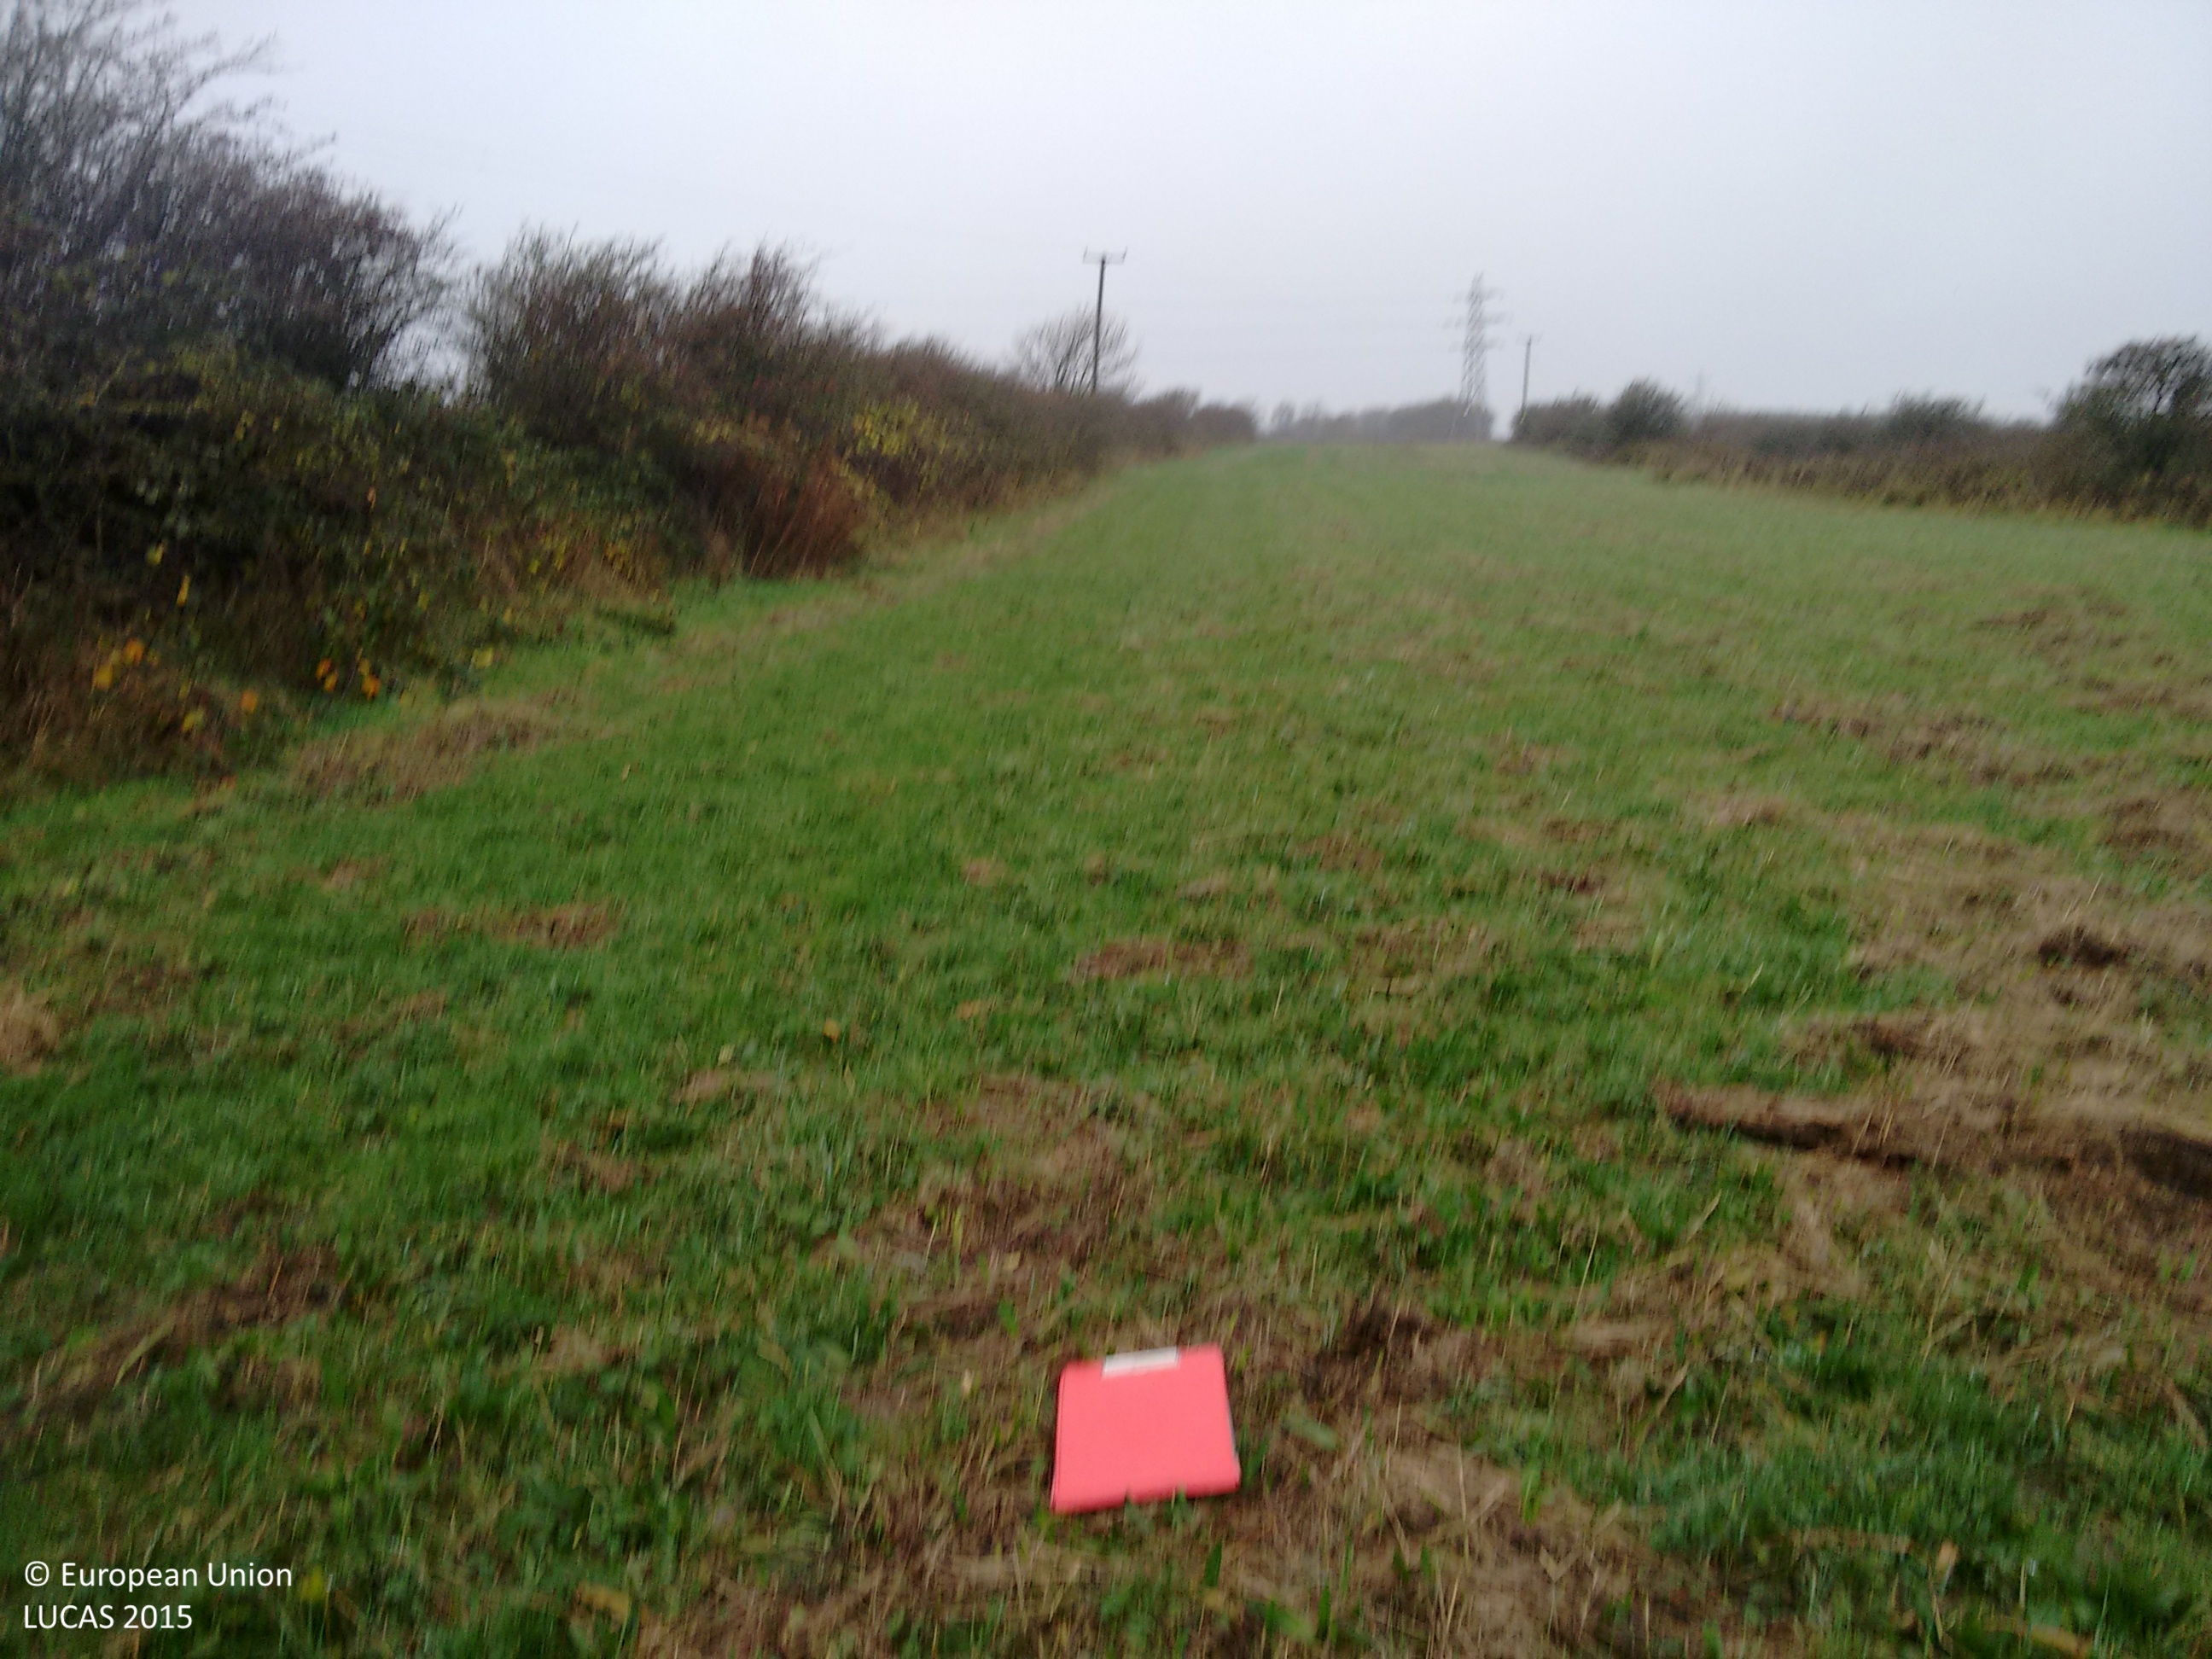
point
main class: Grassland
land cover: Grassland without tree/shrub cover
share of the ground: > 75 %
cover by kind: herbaceous plants 100 %
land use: Agriculture (excluding fallow land and kitchen gardens)
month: November
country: GB
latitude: 54.5342
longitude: -3.5434
